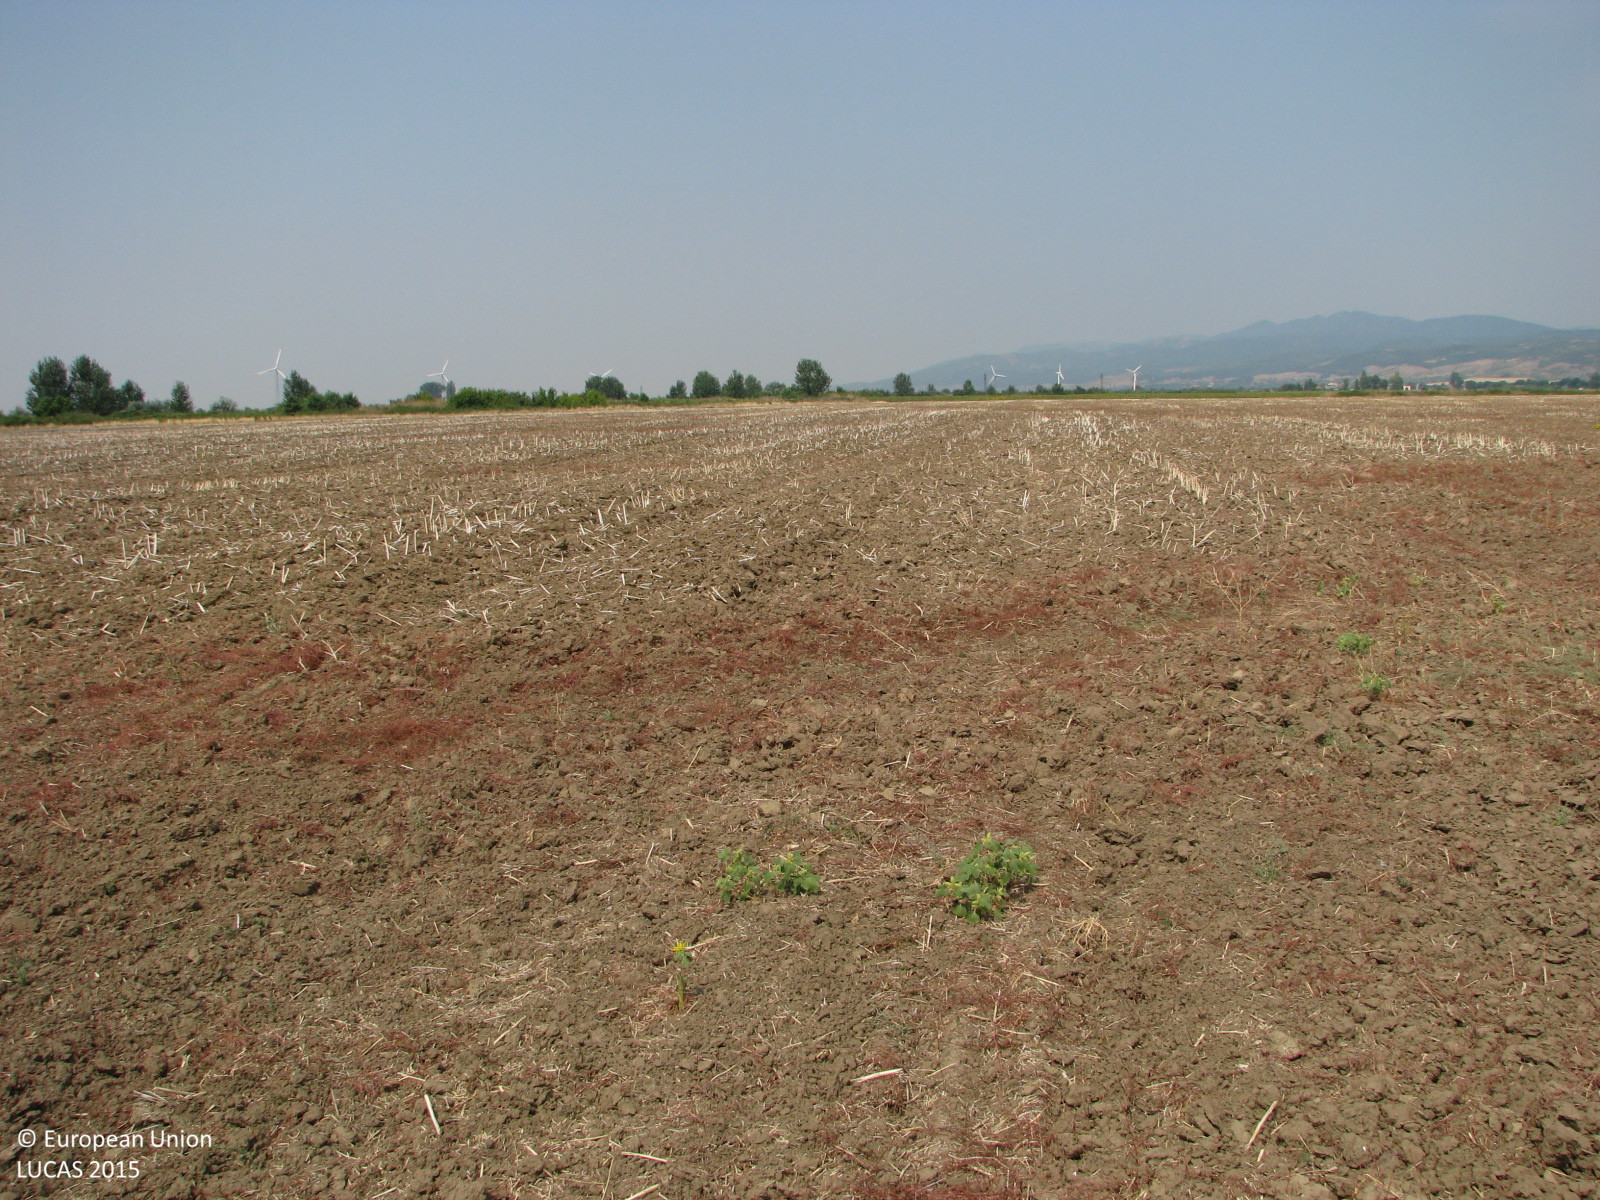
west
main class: Cropland
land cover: Sunflower
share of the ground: < 10 %
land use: Agriculture (excluding fallow land and kitchen gardens)
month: July
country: BG
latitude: 42.6367
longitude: 26.6964
